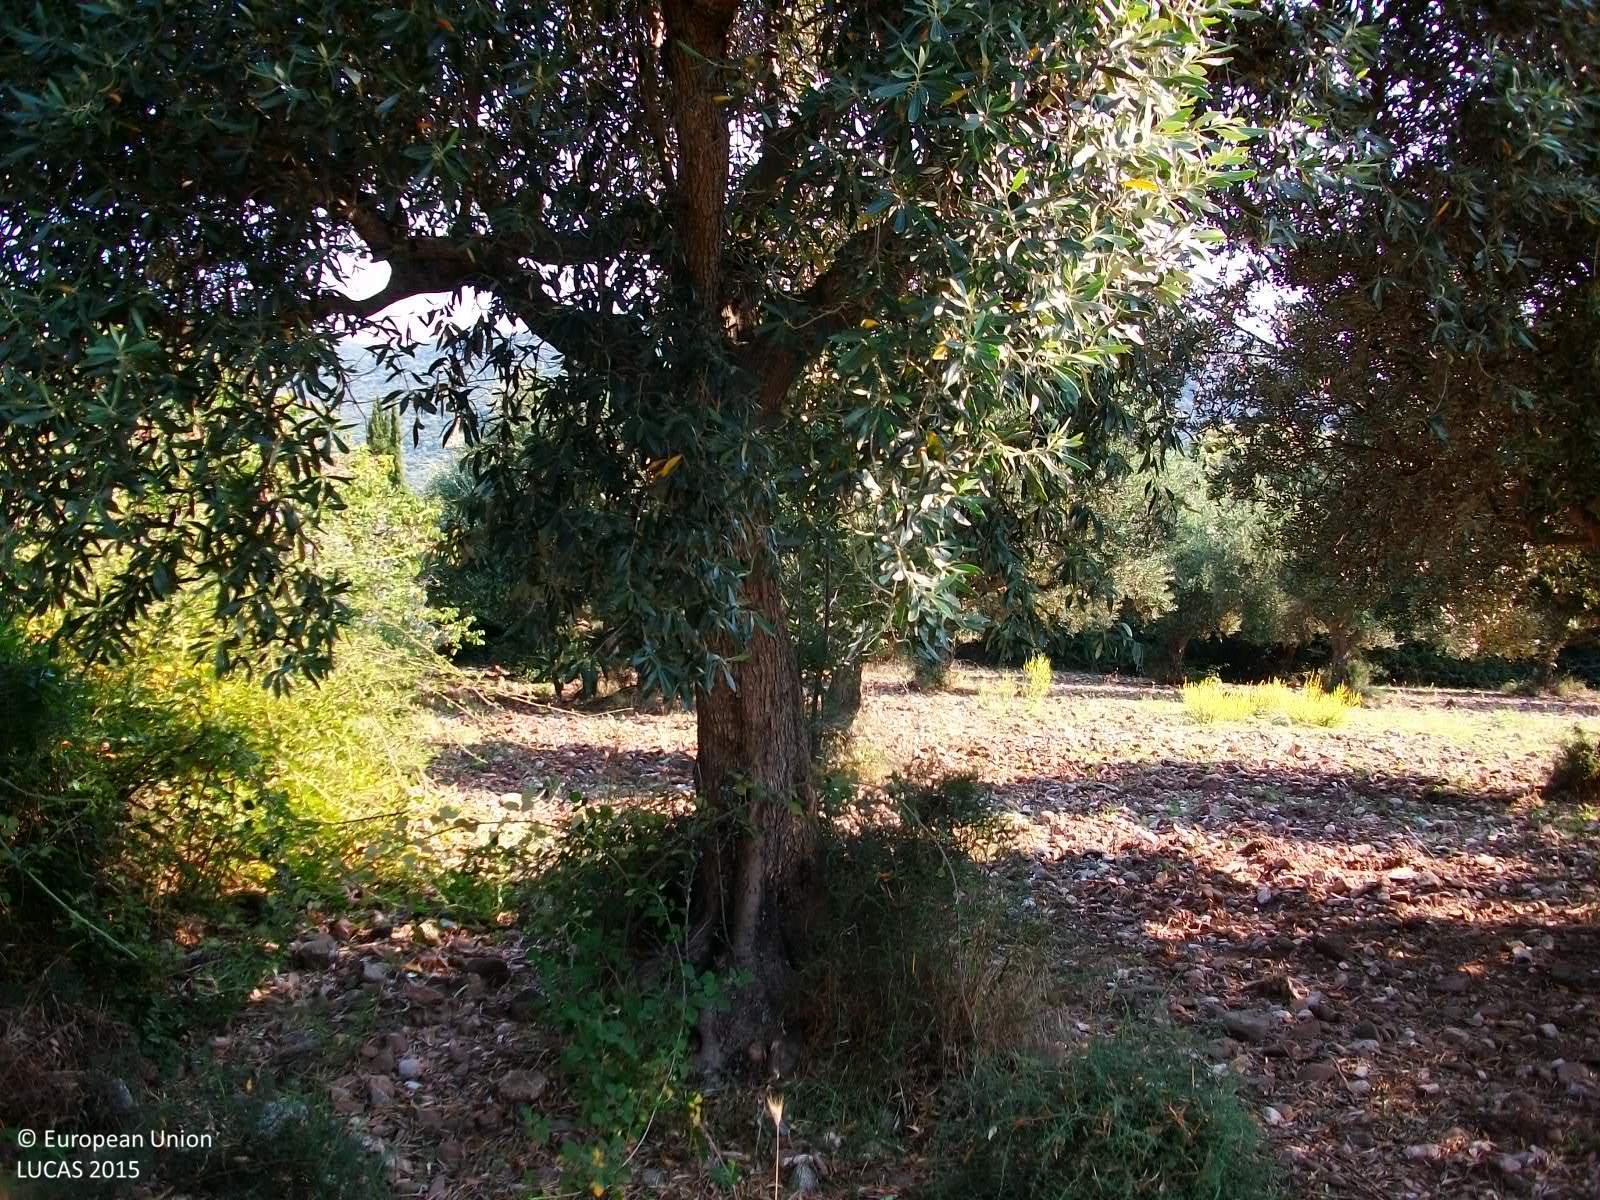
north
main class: Cropland
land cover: Olive groves
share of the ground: 50 - 75 %
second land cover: Spontaneously vegetated surfaces
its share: > 75 %
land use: Agriculture (excluding fallow land and kitchen gardens)
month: July
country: GR
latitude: 37.3233
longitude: 21.9299
